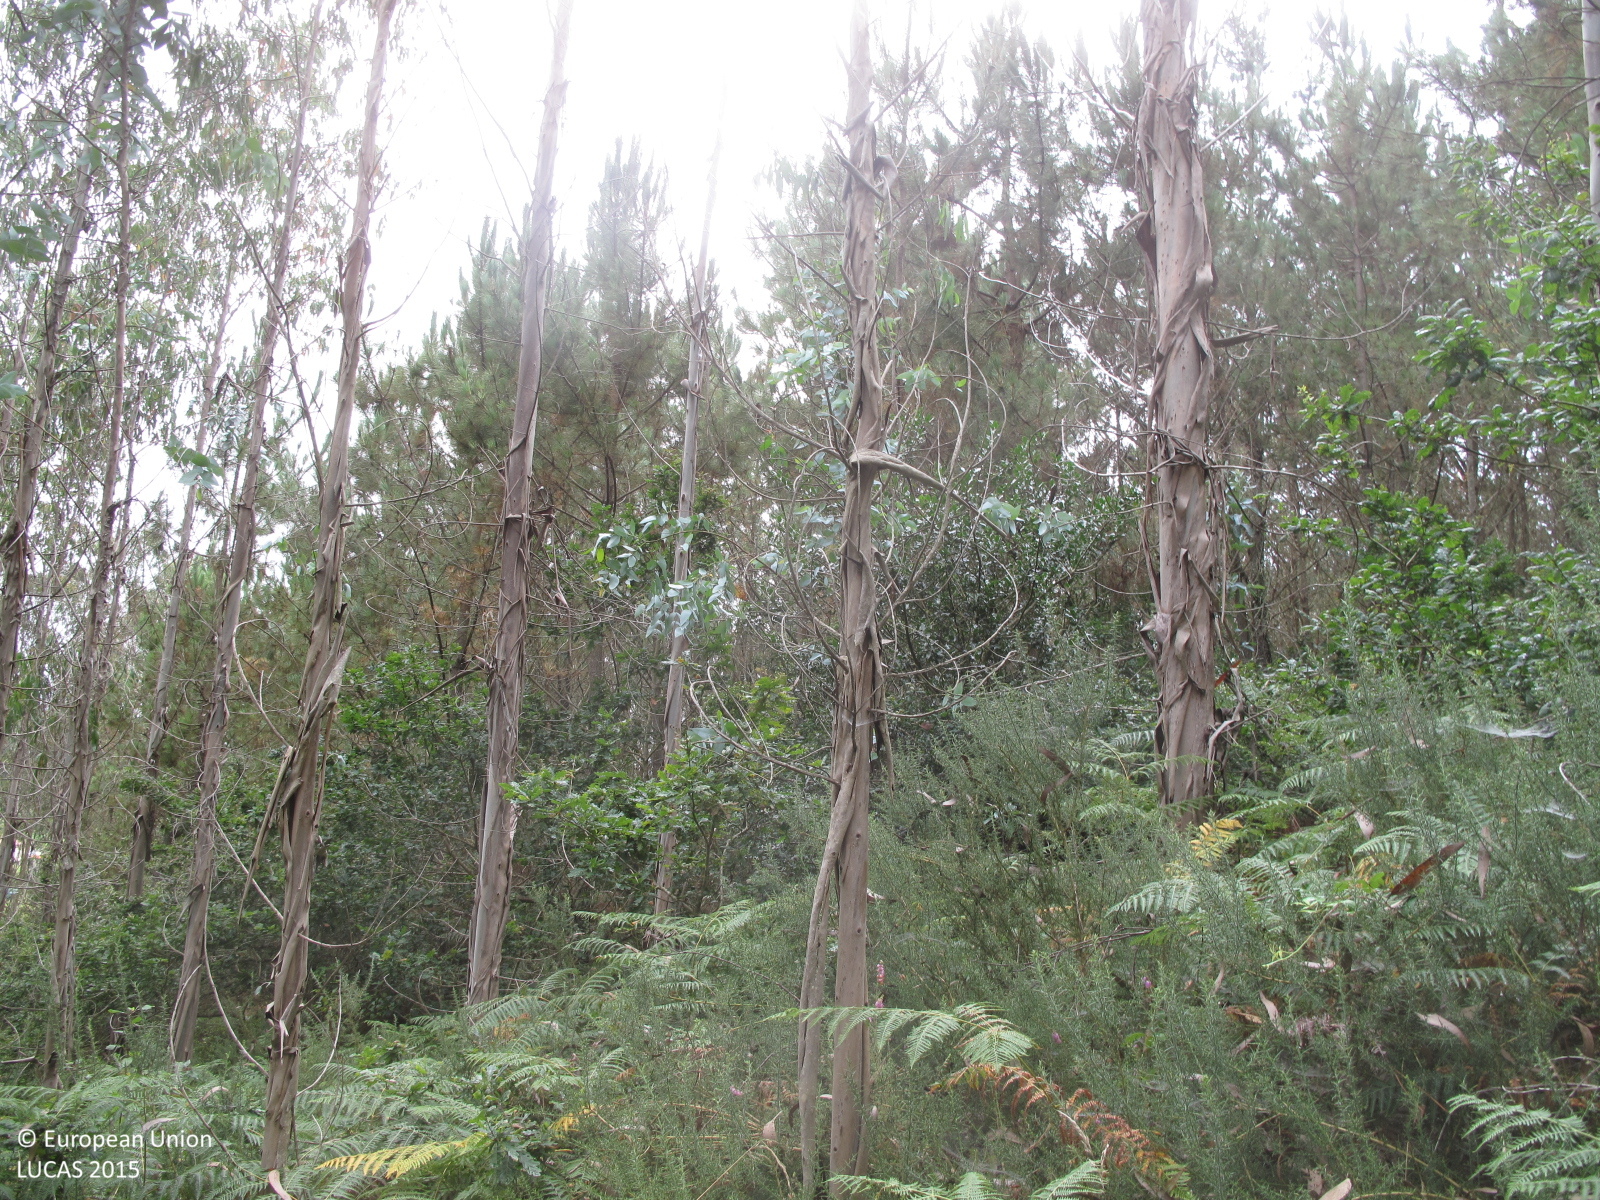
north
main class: Woodland
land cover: Broadleaved woodland
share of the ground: 25 - 50 %
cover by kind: herbaceous plants 50 %, broadleaved forest trees 40 %, shrubs 10 %
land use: Forestry
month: July
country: ES
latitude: 43.0554
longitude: -9.1959
